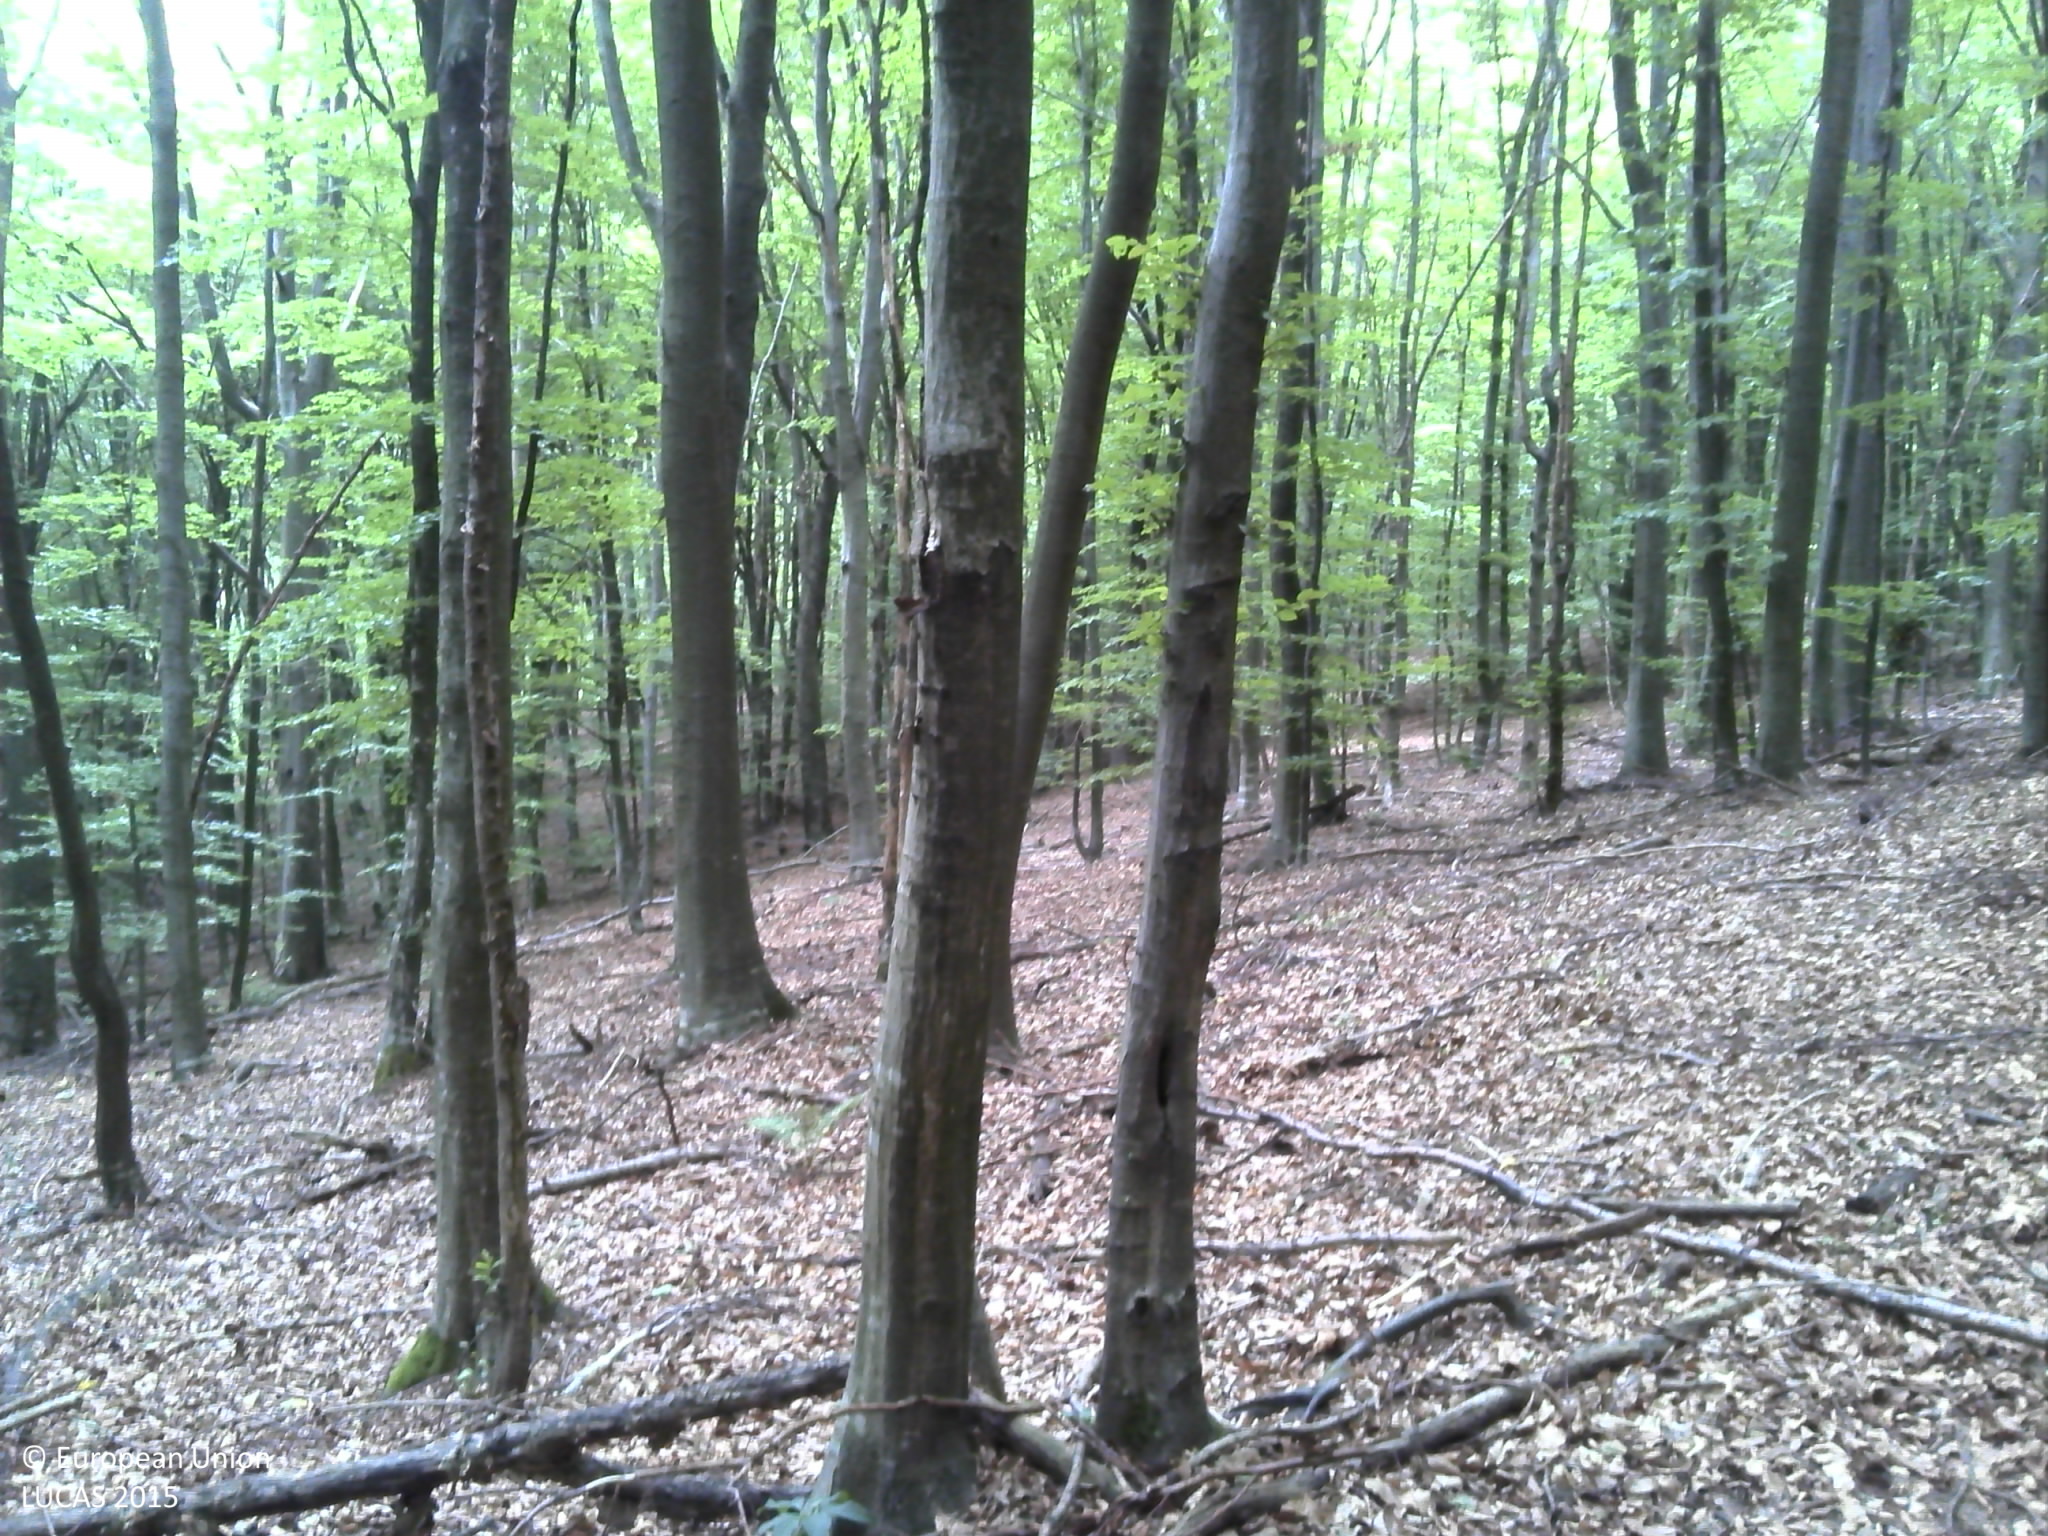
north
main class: Woodland
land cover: Broadleaved woodland
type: beech forest
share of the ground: > 75 %
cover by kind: broadleaved forest trees 80 %, lichens and mosses 20 %
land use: Forestry
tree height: > 5 m
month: June
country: HR
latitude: 45.4738
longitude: 17.4845
